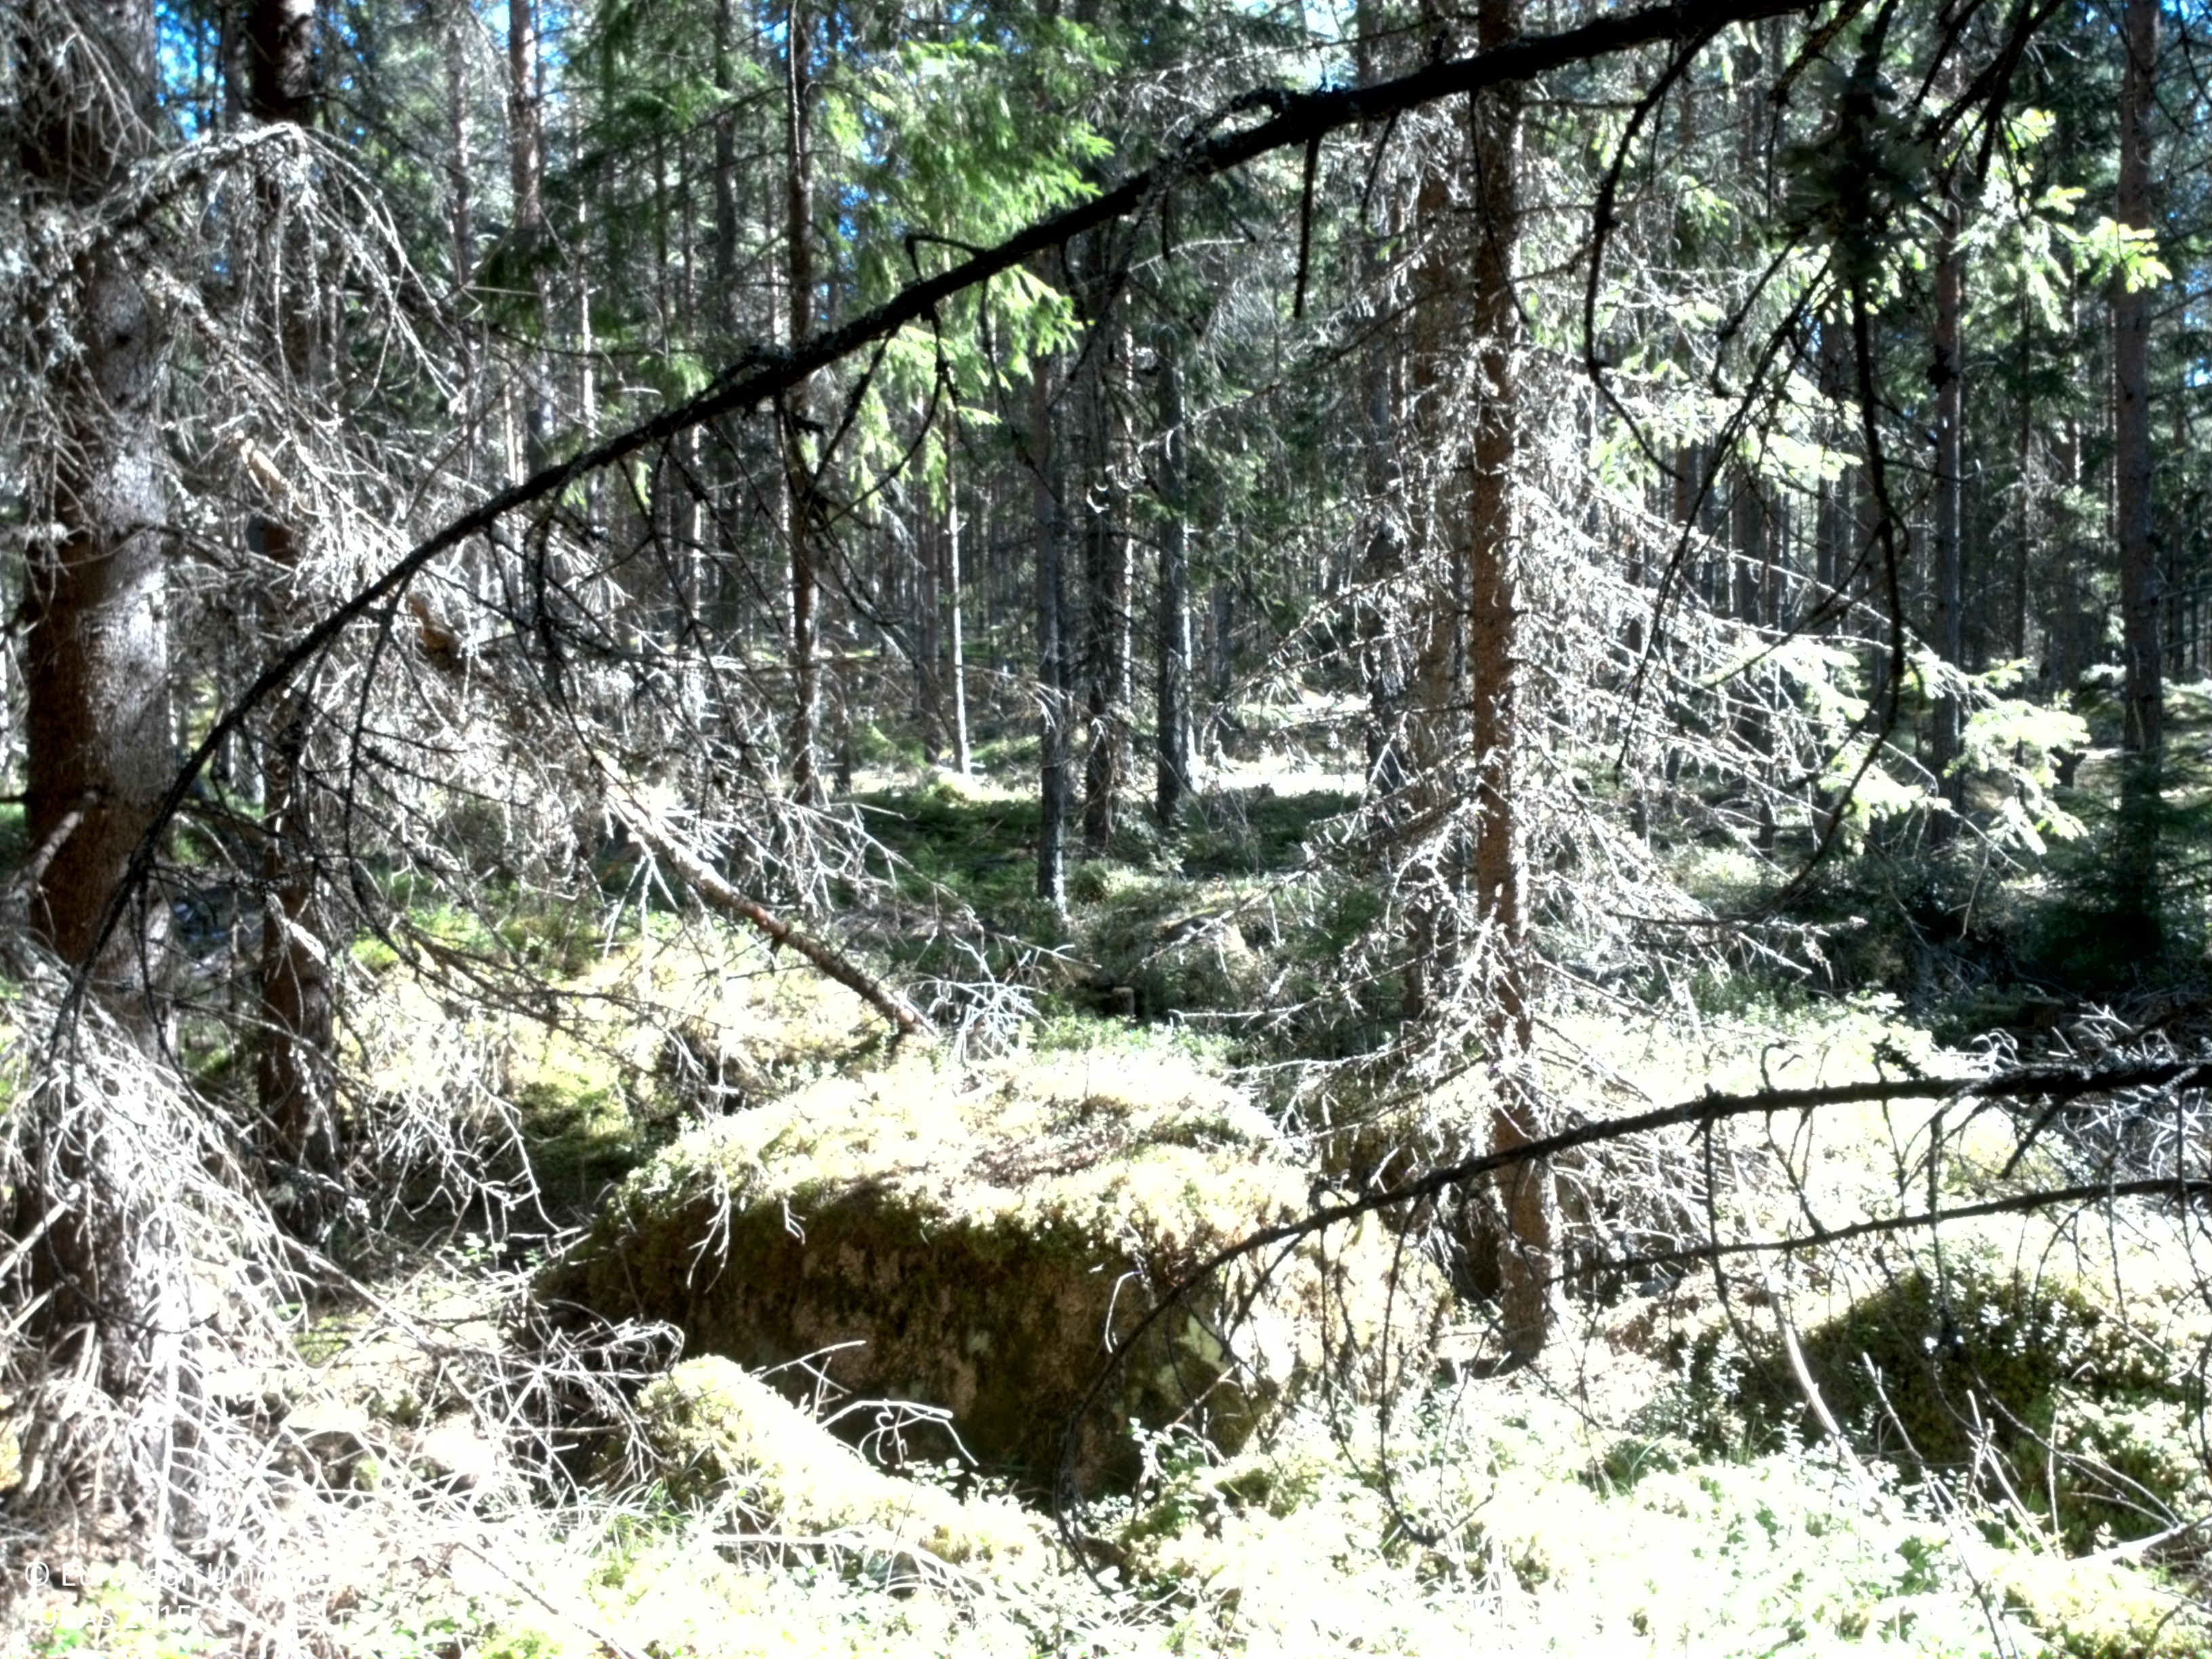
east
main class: Woodland
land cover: Spruce dominated coniferous woodland
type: boreal forest
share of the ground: 50 - 75 %
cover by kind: coniferous forest trees 60 %, lichens and mosses 30 %, shrubs 10 %
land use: Forestry
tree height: > 5 m
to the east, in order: Spruce dominated coniferous woodland; Tracks; Pine dominated coniferous woodland; Tracks; Pine dominated coniferous woodland; Tracks; Pine dominated coniferous woodland
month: August
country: SE
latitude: 60.0824
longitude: 13.5316
